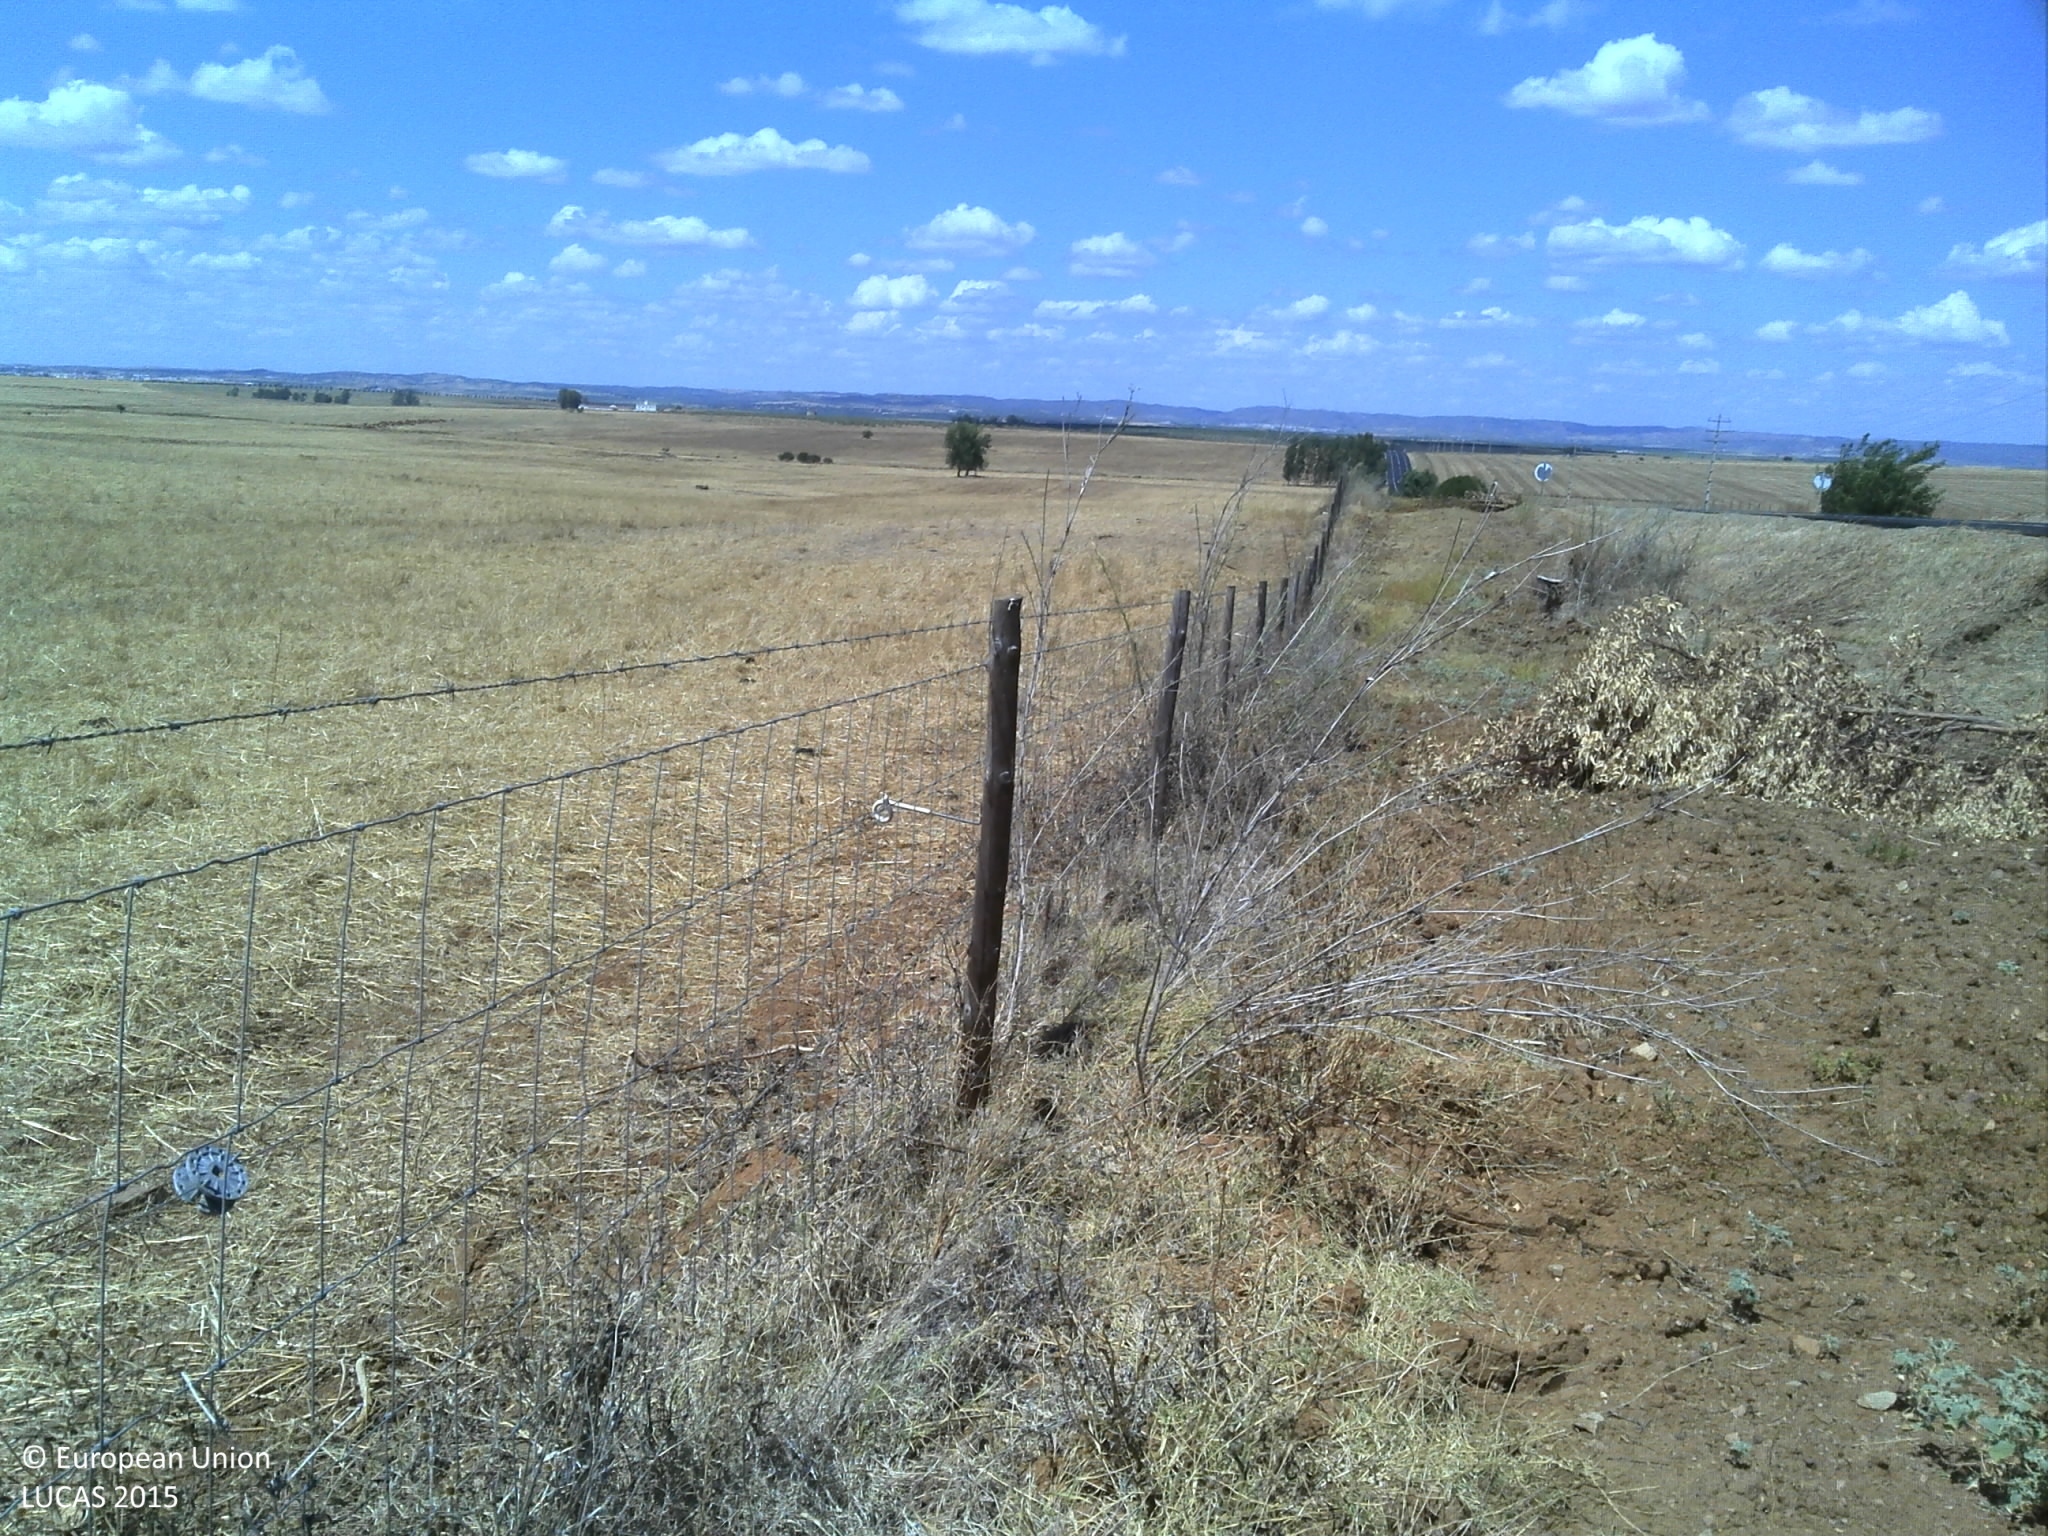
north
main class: Grassland
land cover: Grassland without tree/shrub cover
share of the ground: > 75 %
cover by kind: herbaceous plants 85 %, unconsolidated bare surface 15 %
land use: Agriculture (excluding fallow land and kitchen gardens)
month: July
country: PT
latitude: 38.0755
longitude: -7.8695
